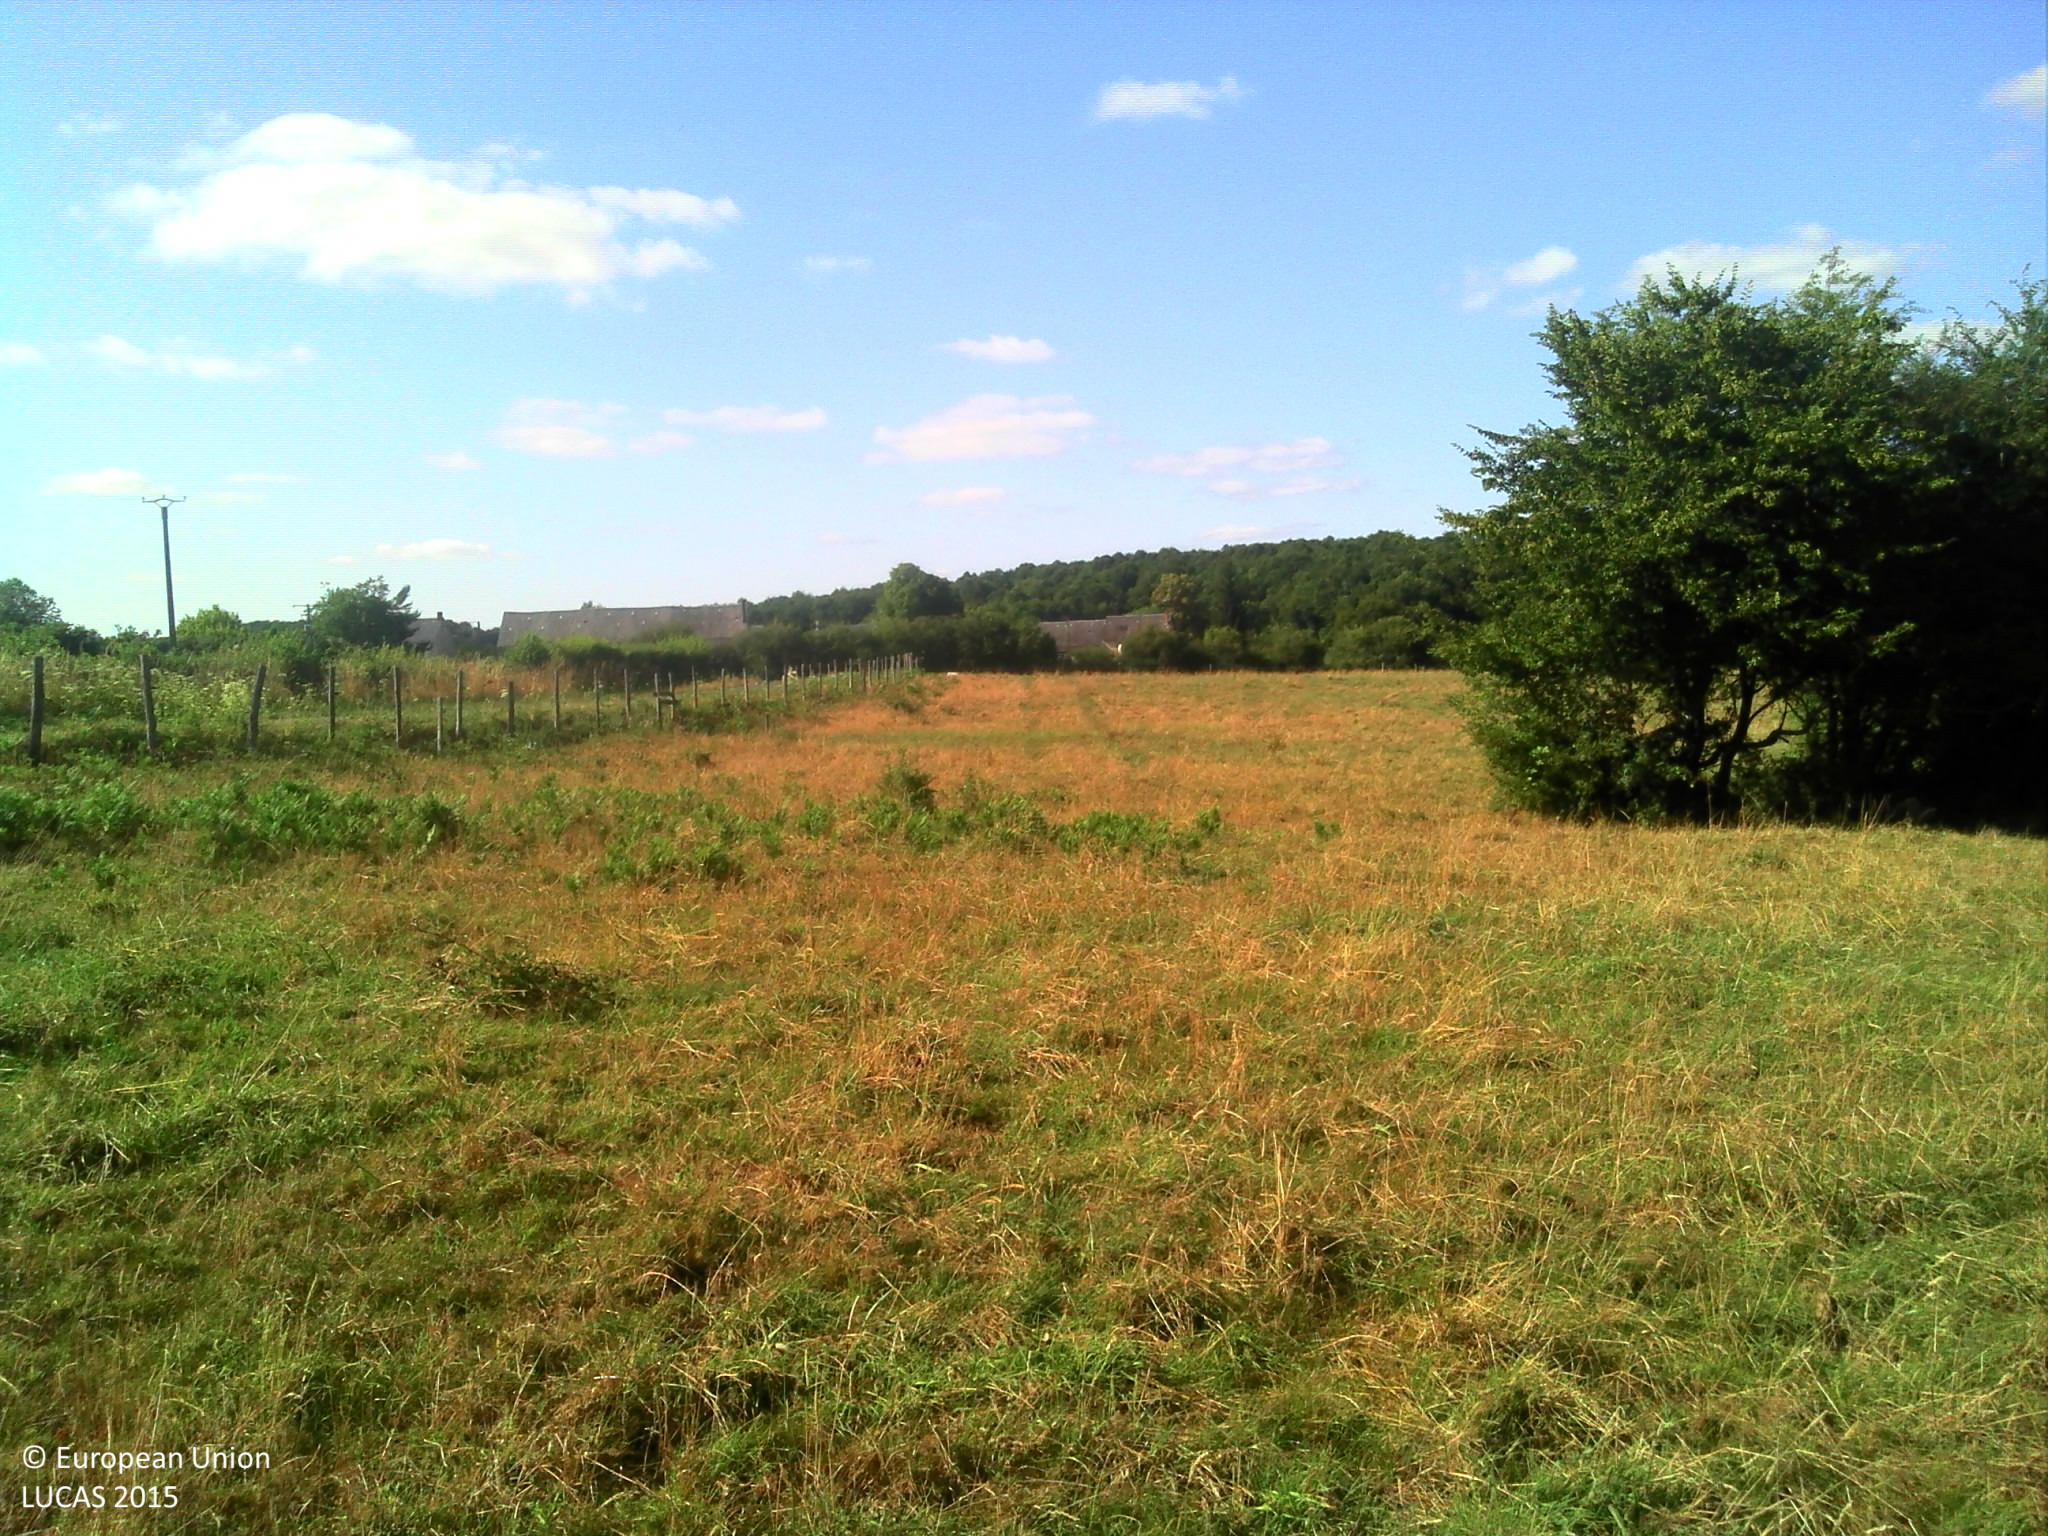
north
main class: Grassland
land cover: Grassland without tree/shrub cover
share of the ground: > 75 %
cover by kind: herbaceous plants 100 %
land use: Agriculture (excluding fallow land and kitchen gardens)
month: July
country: FR
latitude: 46.3072
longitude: 1.5639
